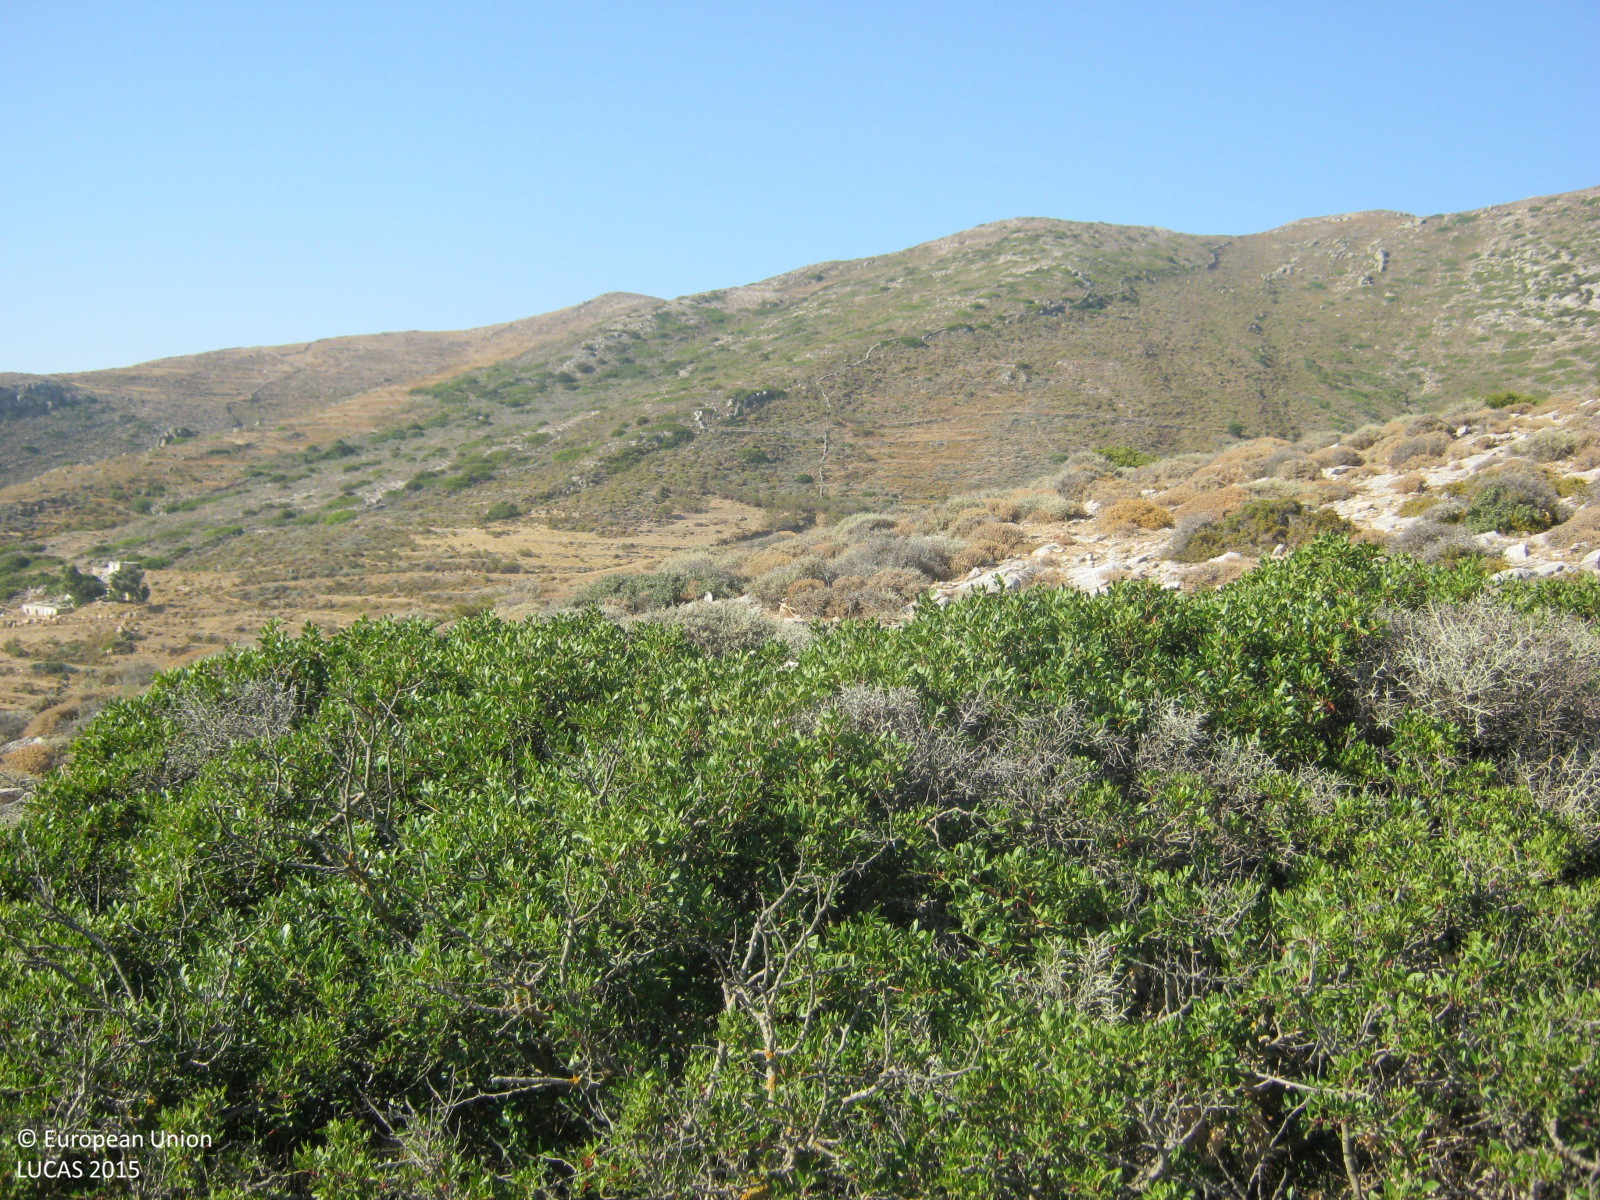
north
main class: Shrubland
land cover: Shrubland without tree cover
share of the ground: 50 - 75 %
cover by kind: shrubs 55 %, unconsolidated bare surface 40 %, herbaceous plants 5 %
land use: Agriculture (excluding fallow land and kitchen gardens)
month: August
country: GR
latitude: 37.0382
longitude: 25.1711
